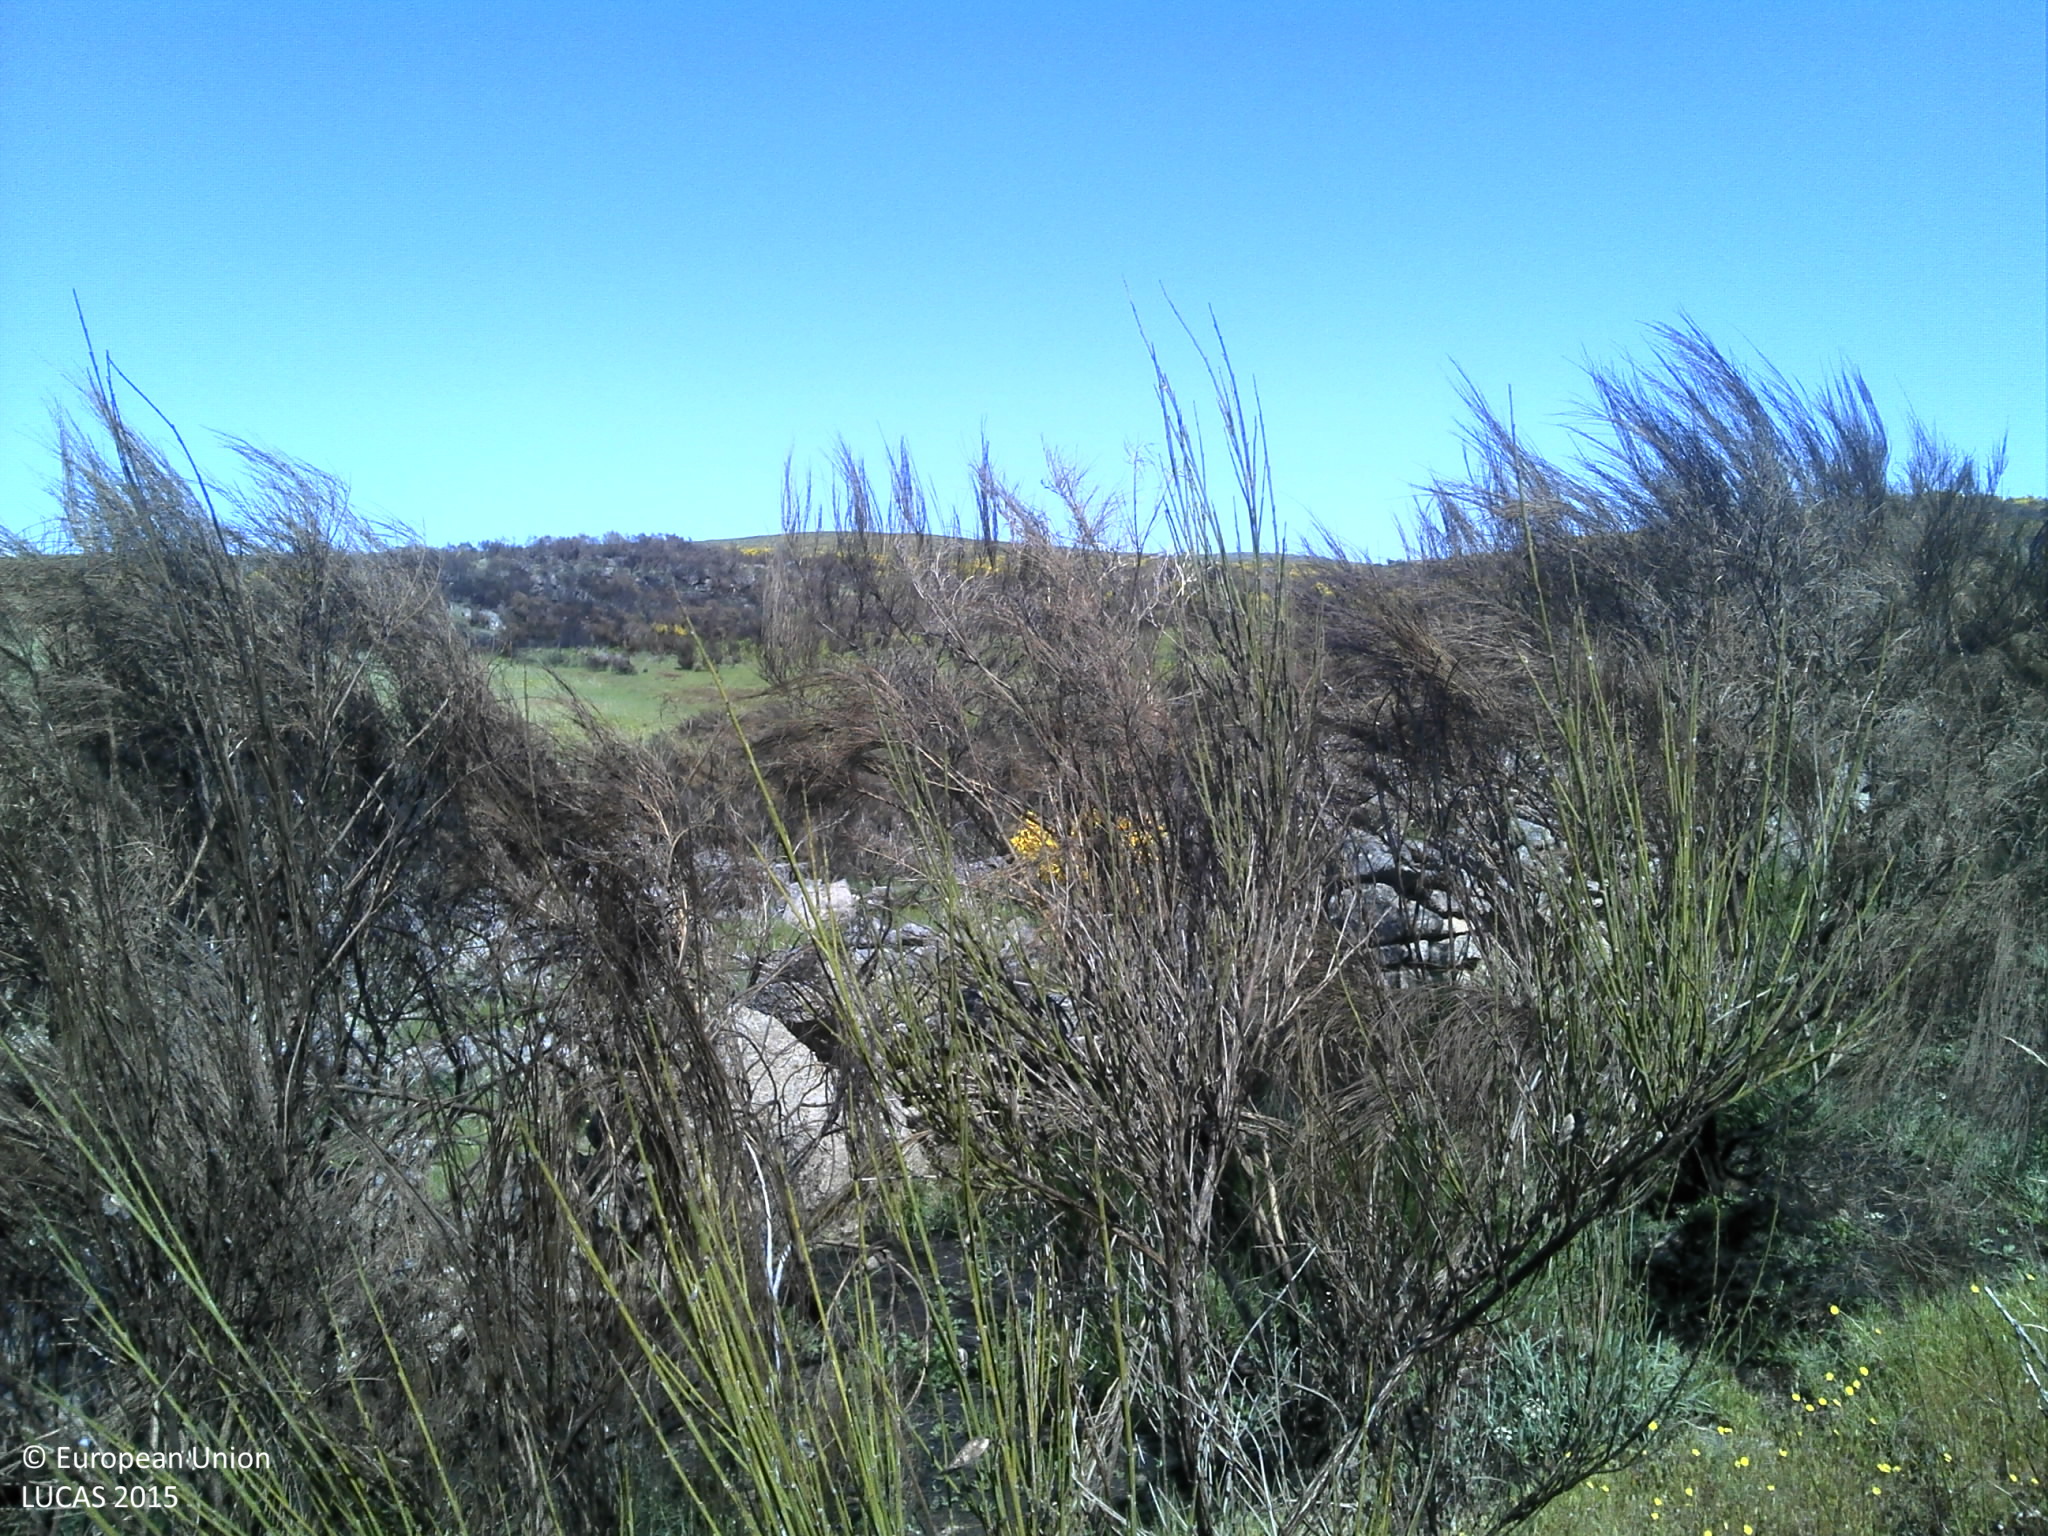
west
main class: Shrubland
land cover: Shrubland without tree cover
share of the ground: 50 - 75 %
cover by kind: shrubs 65 %, unconsolidated bare surface 20 %, herbaceous plants 5 %
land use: Semi-natural and natural areas not in use
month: May
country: PT
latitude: 40.5295
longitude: -7.3791
